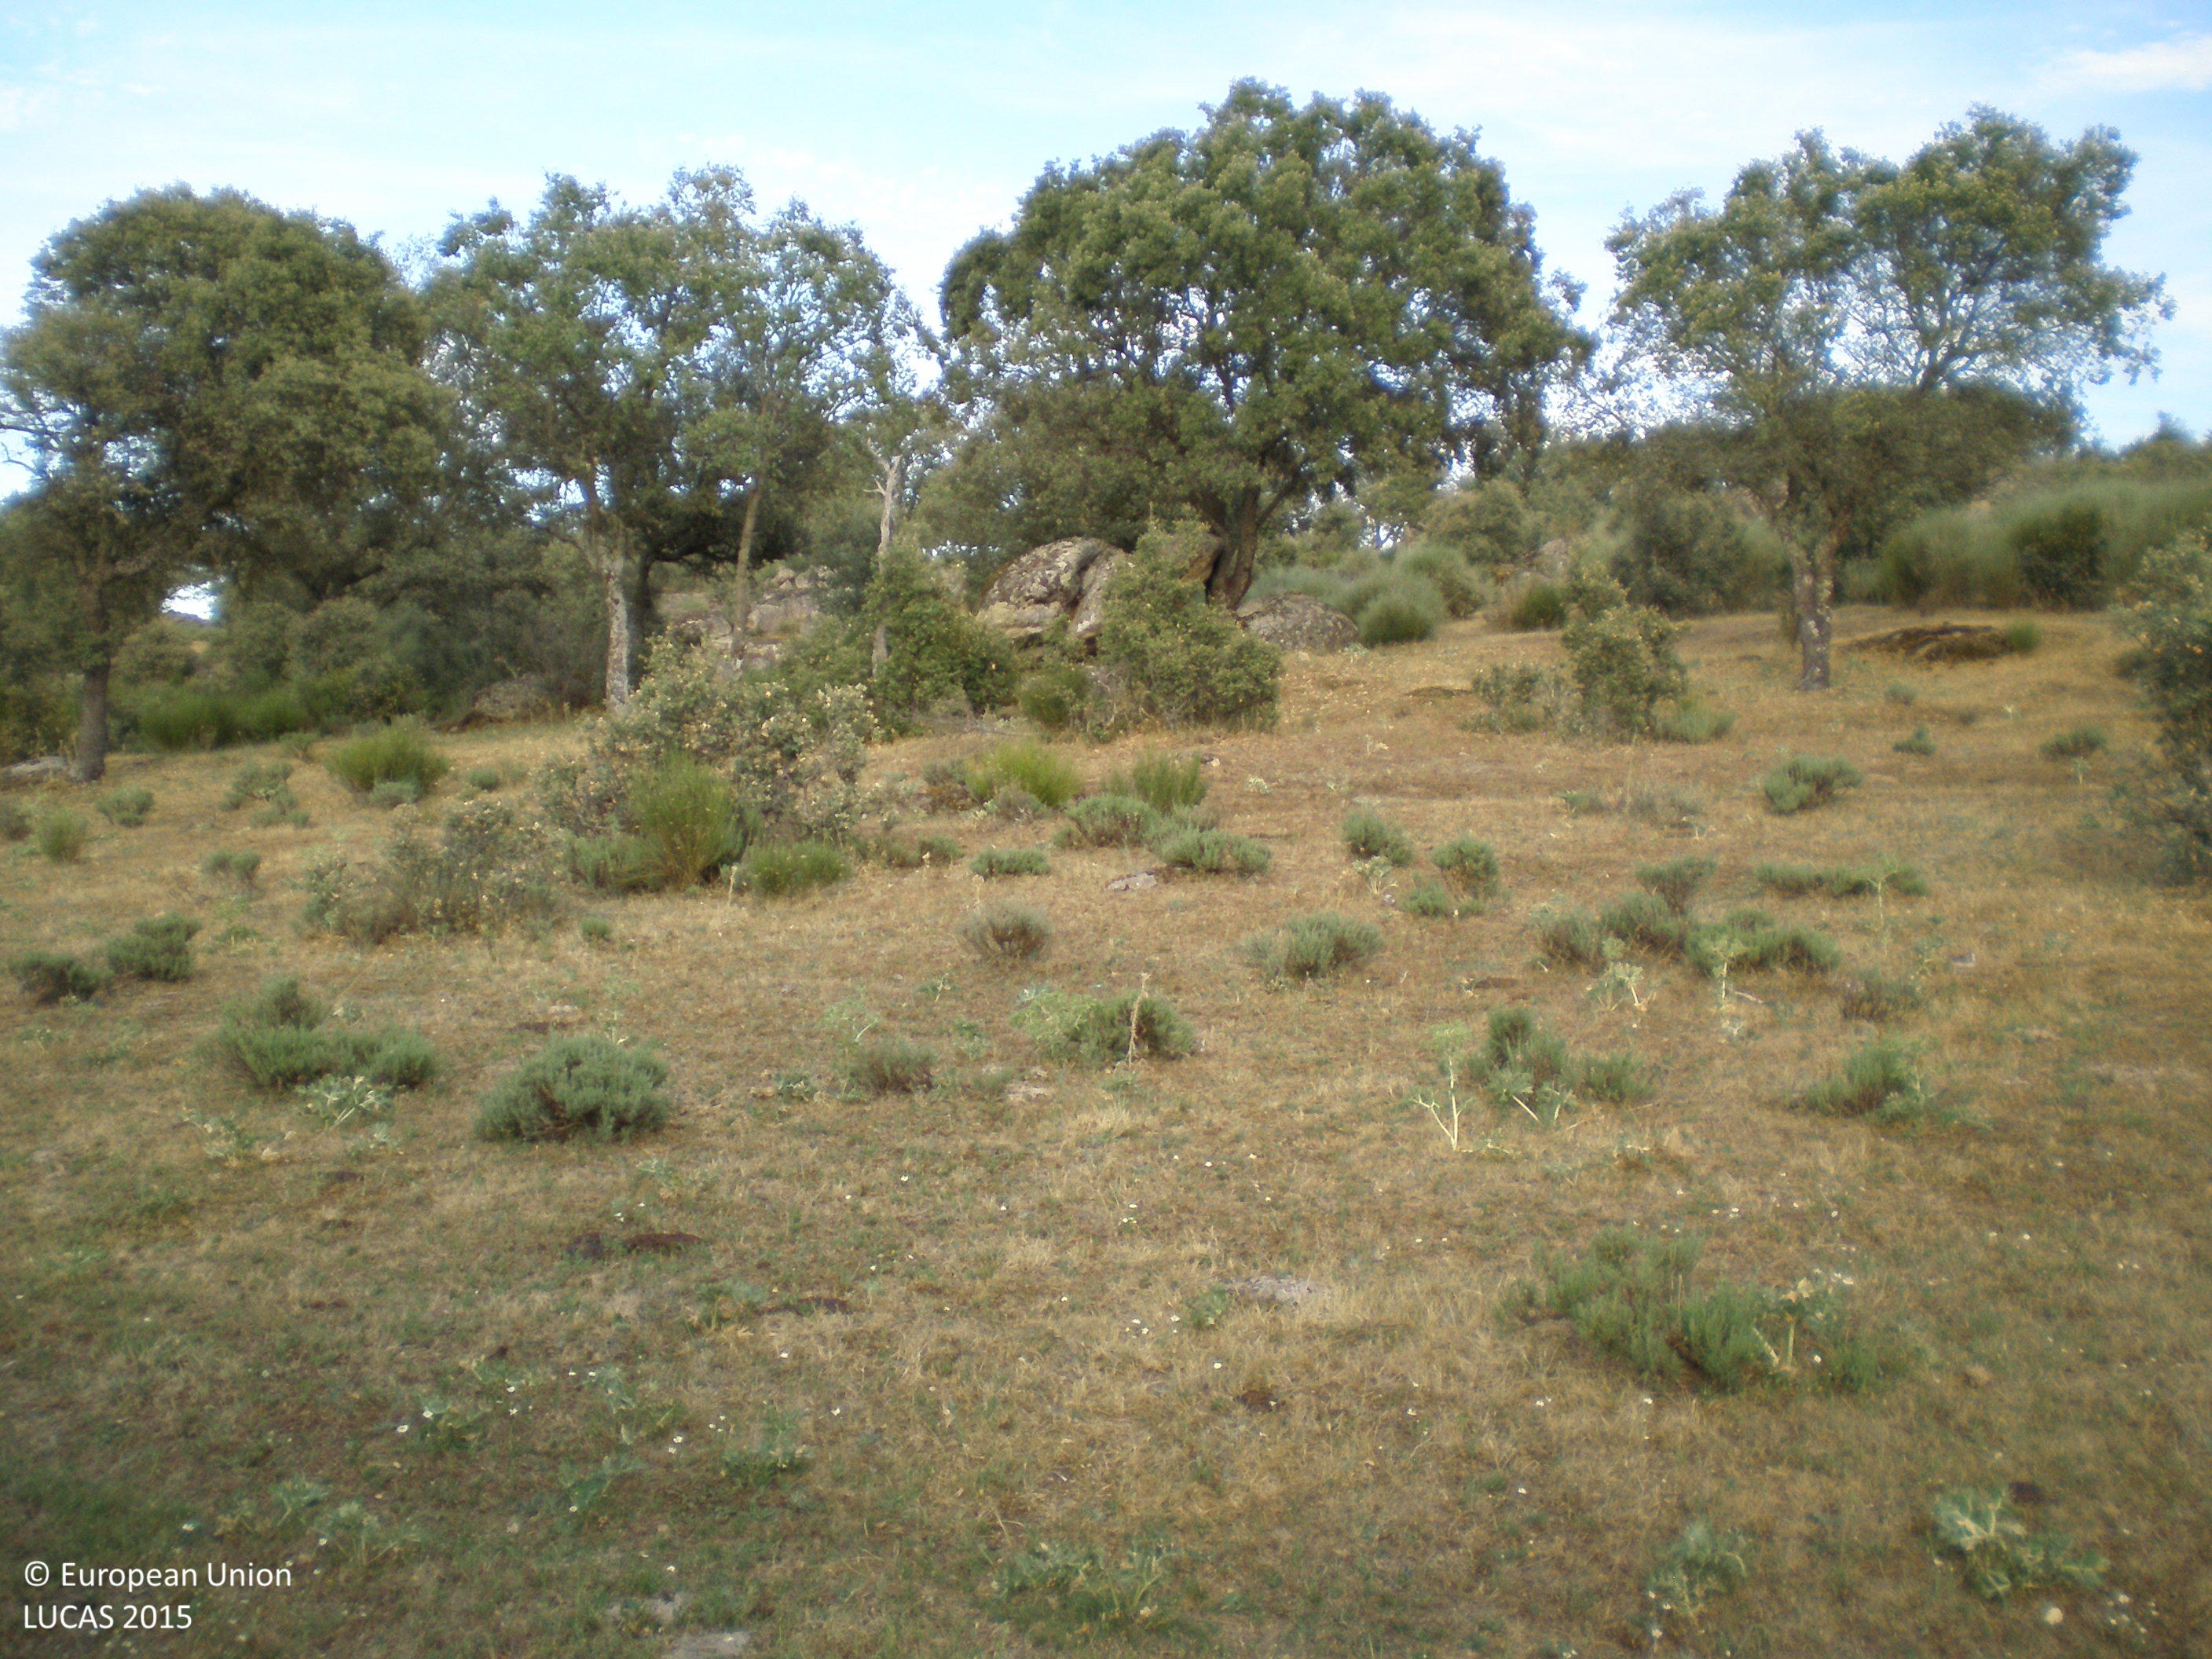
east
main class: Grassland
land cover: Grassland with sparse tree/shrub cover
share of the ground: > 75 %
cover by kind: herbaceous plants 95 %, broadleaved forest trees 5 %
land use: Agriculture (excluding fallow land and kitchen gardens)
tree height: < 5 m
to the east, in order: Grassland with sparse tree/shrub cover; Broadleaved woodland; Grassland with sparse tree/shrub cover; Broadleaved woodland; Rocks and stones; Tracks; Broadleaved woodland; Rocks and stones; Broadleaved woodland
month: July
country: ES
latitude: 40.5160
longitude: -5.6137
